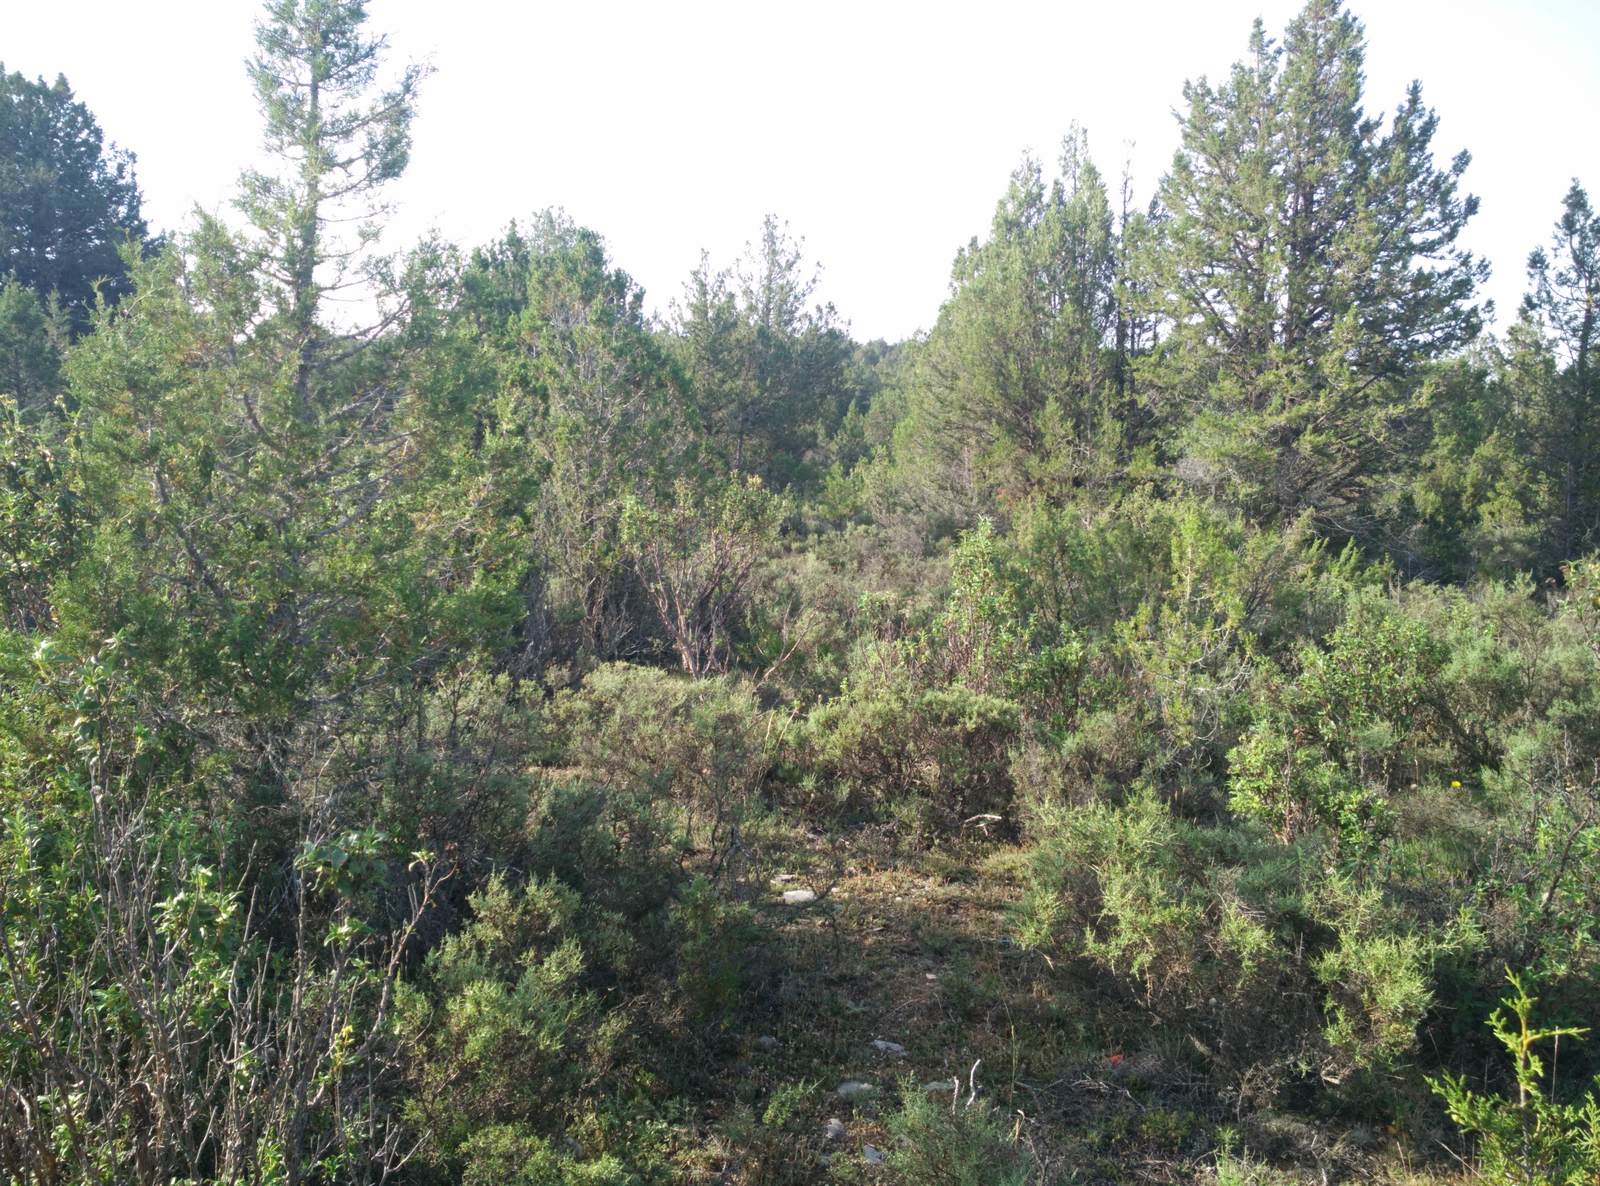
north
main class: Woodland
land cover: Other coniferous woodland
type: coniferous forest of the mediterranean region
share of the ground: 25 - 50 %
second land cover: Shrubland without tree cover
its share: 50 - 75 %
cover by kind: shrubs 50 %, coniferous forest trees 25 %, unconsolidated bare surface 25 %
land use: Forestry
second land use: Agriculture (excluding fallow land and kitchen gardens)
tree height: > 5 m
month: July
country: ES
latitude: 40.9719
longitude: -1.9912
